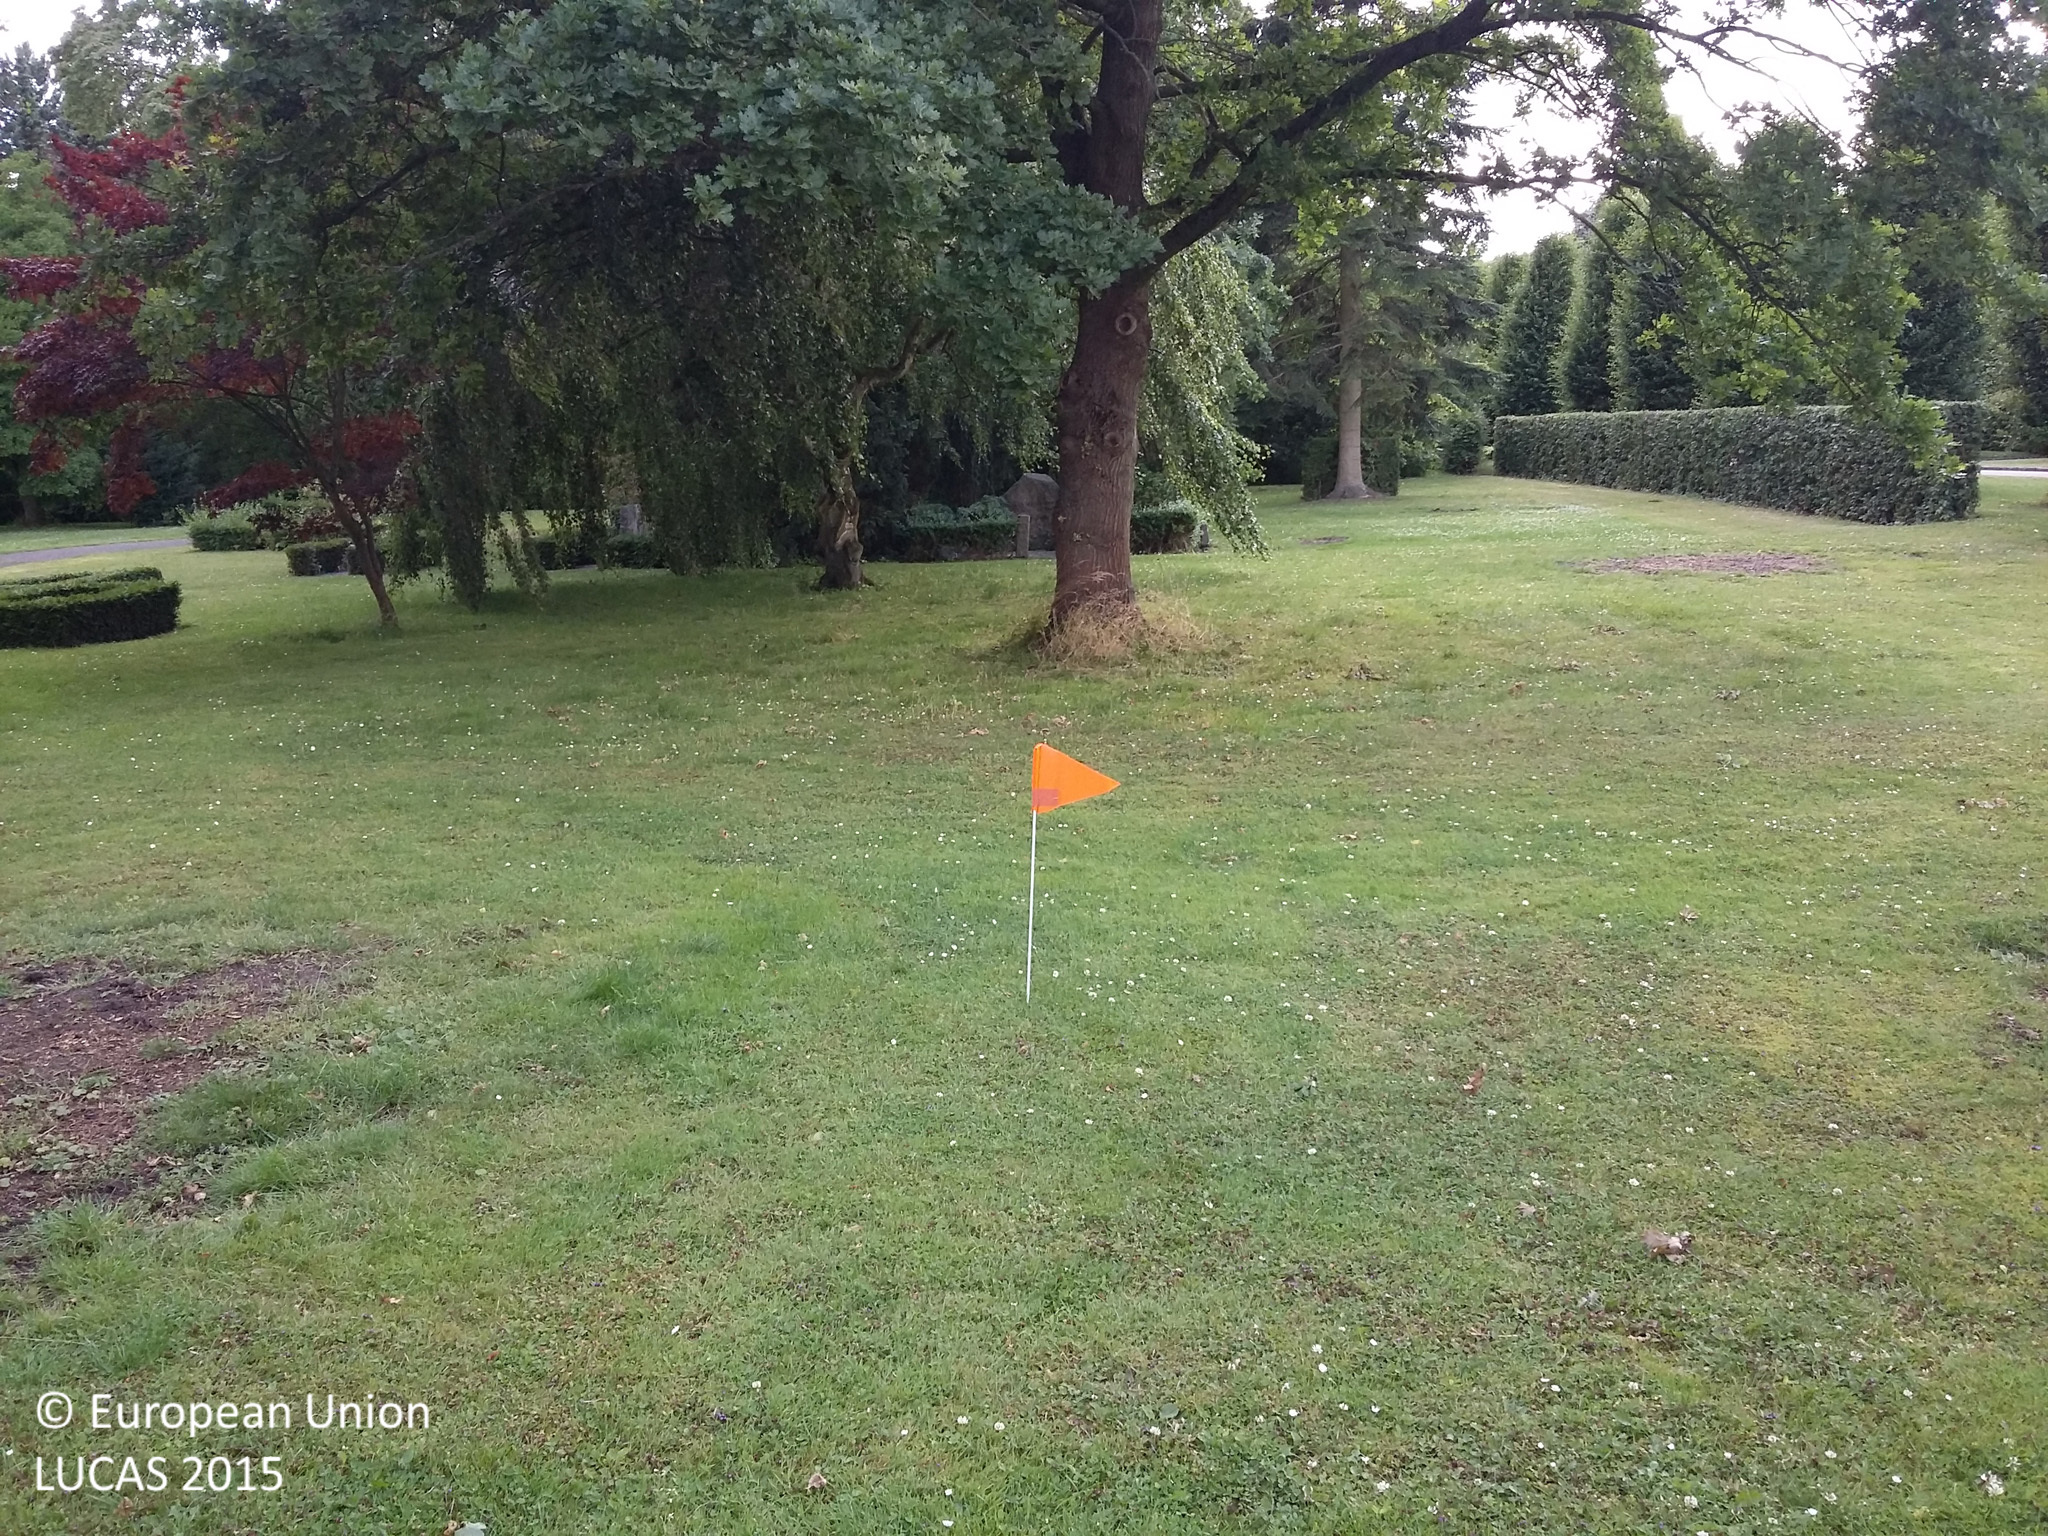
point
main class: Woodland
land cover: Other mixed woodland
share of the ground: 50 - 75 %
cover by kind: broadleaved forest trees 55 %, herbaceous plants 25 %, coniferous forest trees 20 %
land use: Community services
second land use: Amenities, museums, leisure
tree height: > 5 m
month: July
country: DK
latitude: 55.7133
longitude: 12.5288
